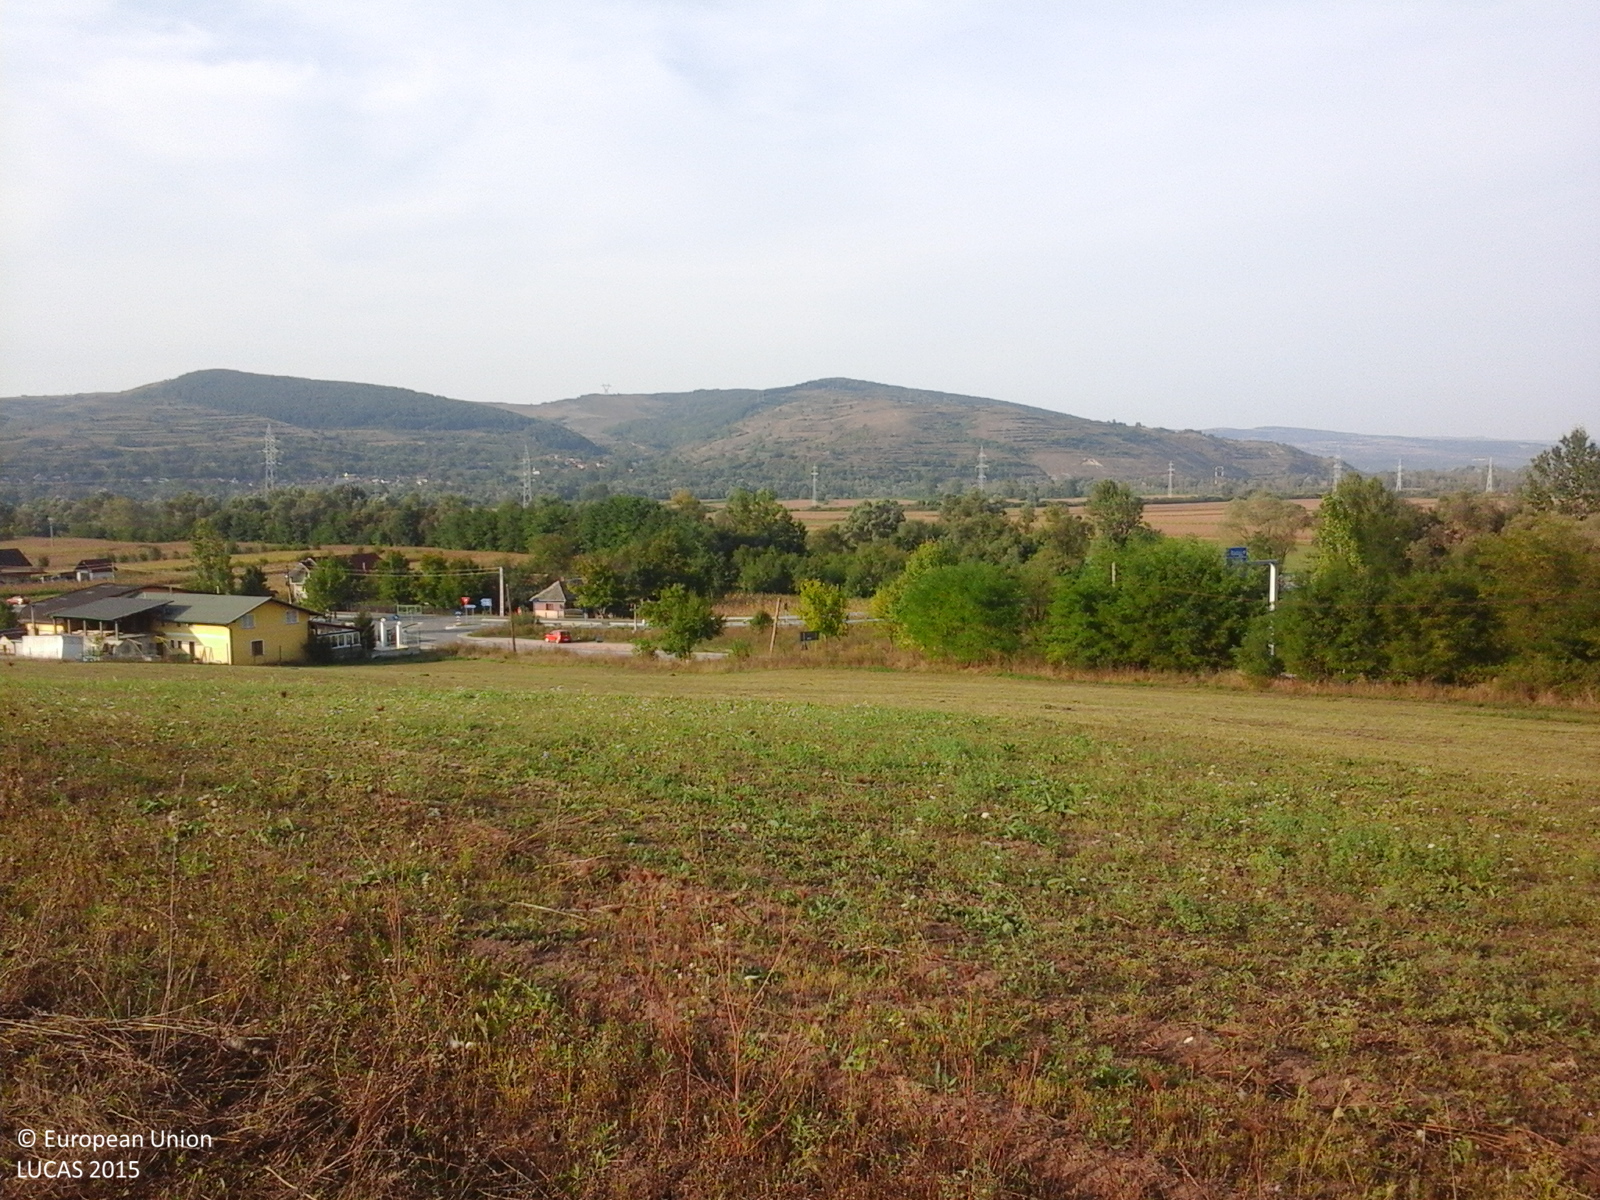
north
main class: Cropland
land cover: Other fruit trees and berries
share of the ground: > 75 %
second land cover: Grassland without tree/shrub cover
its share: > 75 %
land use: Agriculture (excluding fallow land and kitchen gardens)
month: September
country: RO
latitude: 47.2289
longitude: 23.3161
